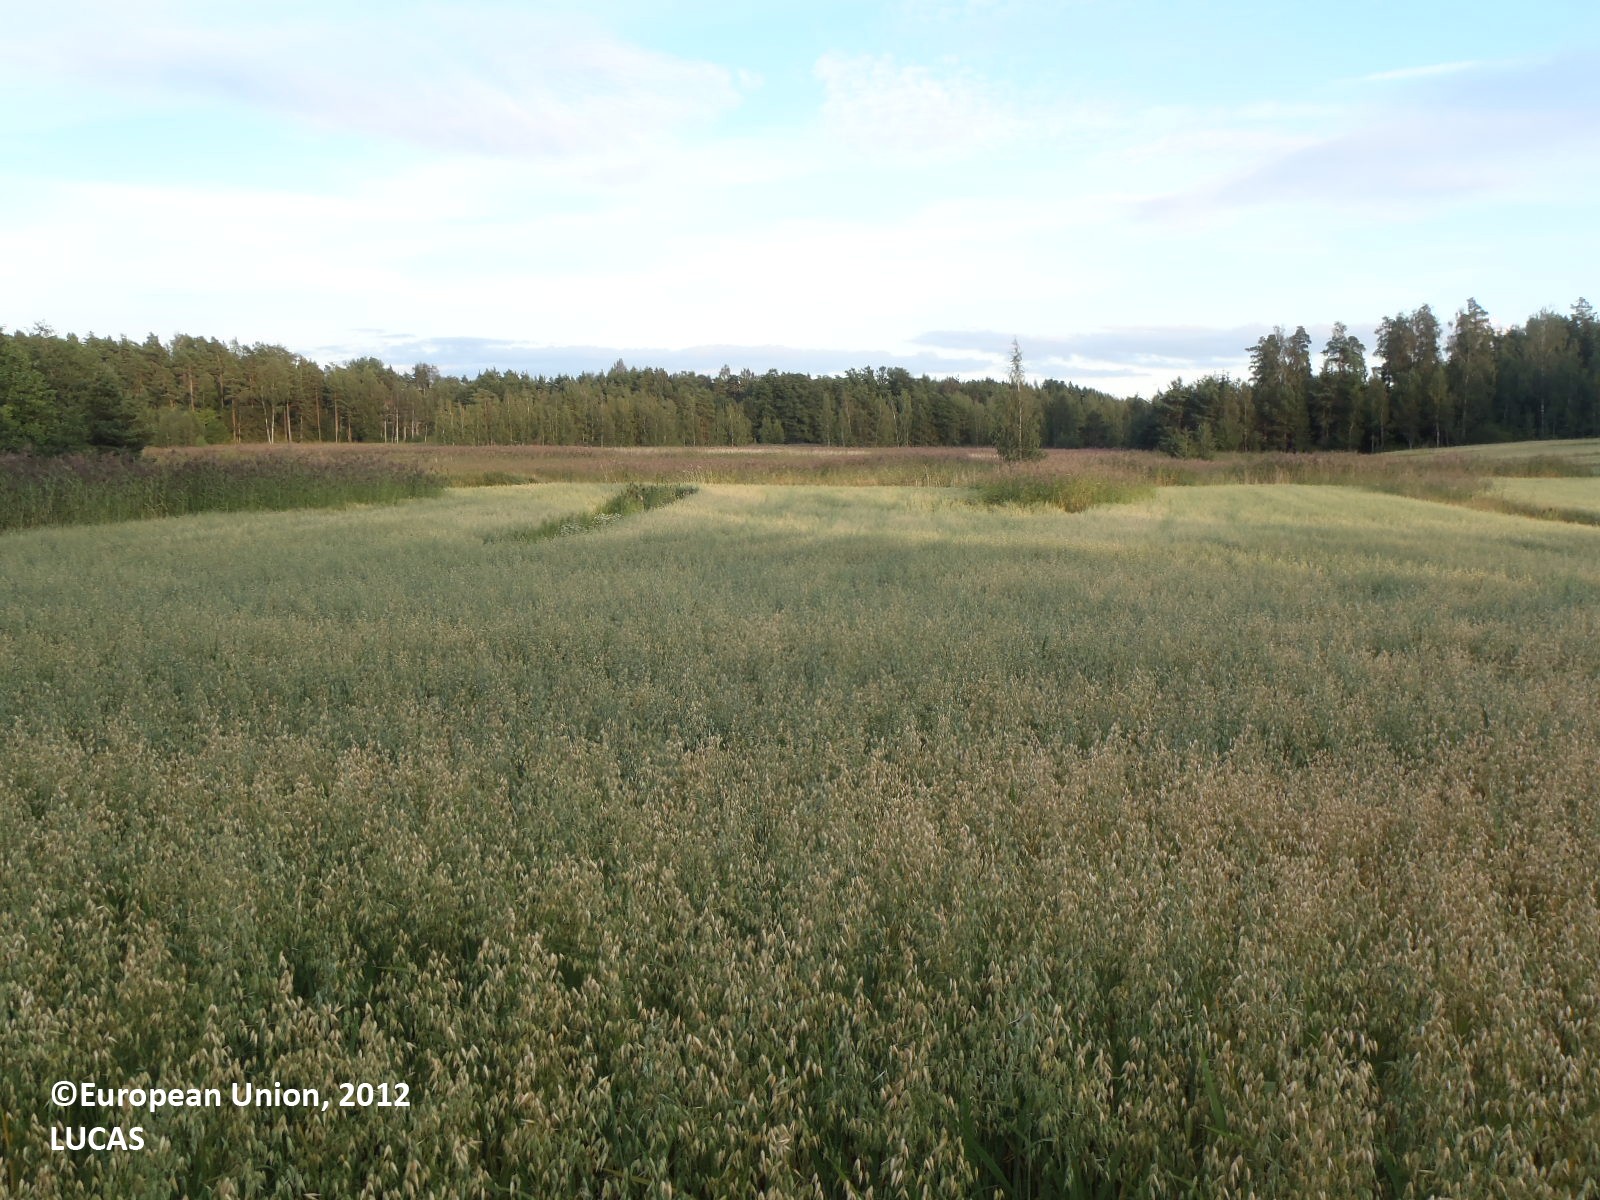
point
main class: Cropland
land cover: Oats
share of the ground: > 75 %
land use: Agriculture (excluding fallow land and kitchen gardens)
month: August
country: FI
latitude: 60.2133
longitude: 22.2131
